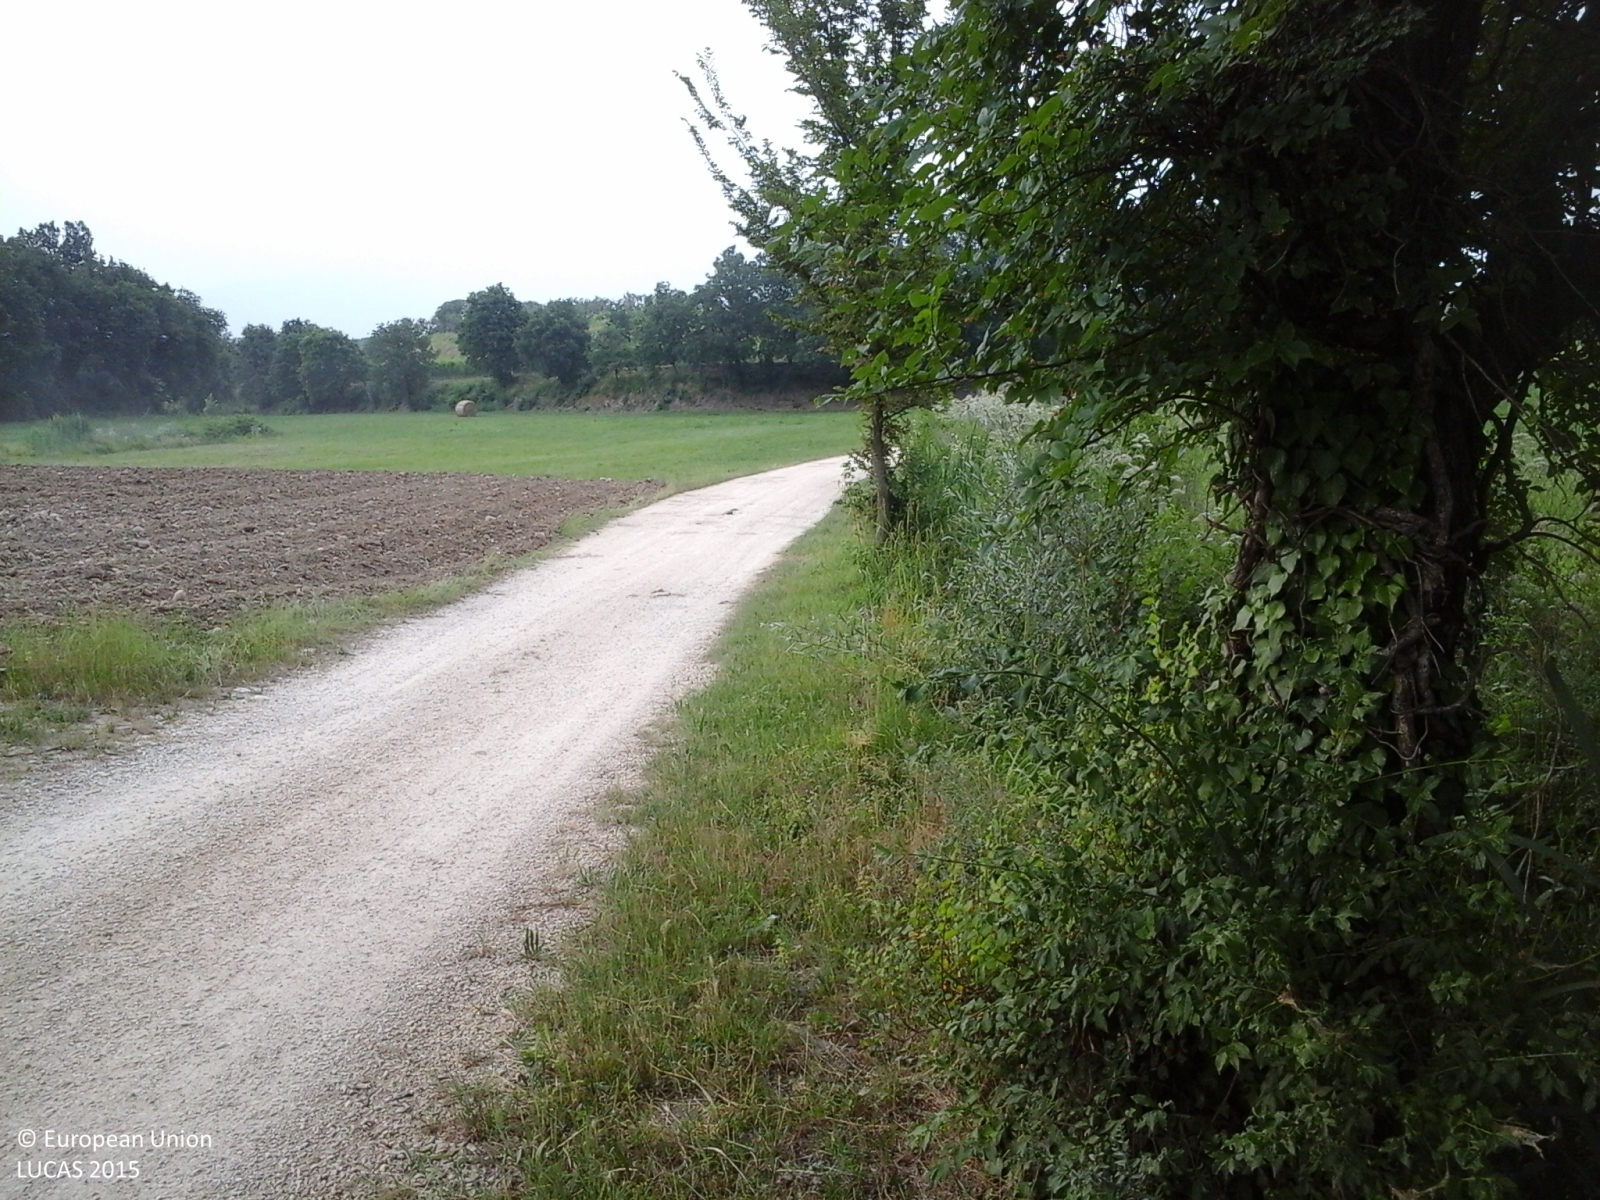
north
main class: Grassland
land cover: Grassland without tree/shrub cover
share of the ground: > 75 %
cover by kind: herbaceous plants 100 %
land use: Agriculture (excluding fallow land and kitchen gardens)
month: June
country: IT
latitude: 45.4837
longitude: 10.7536
